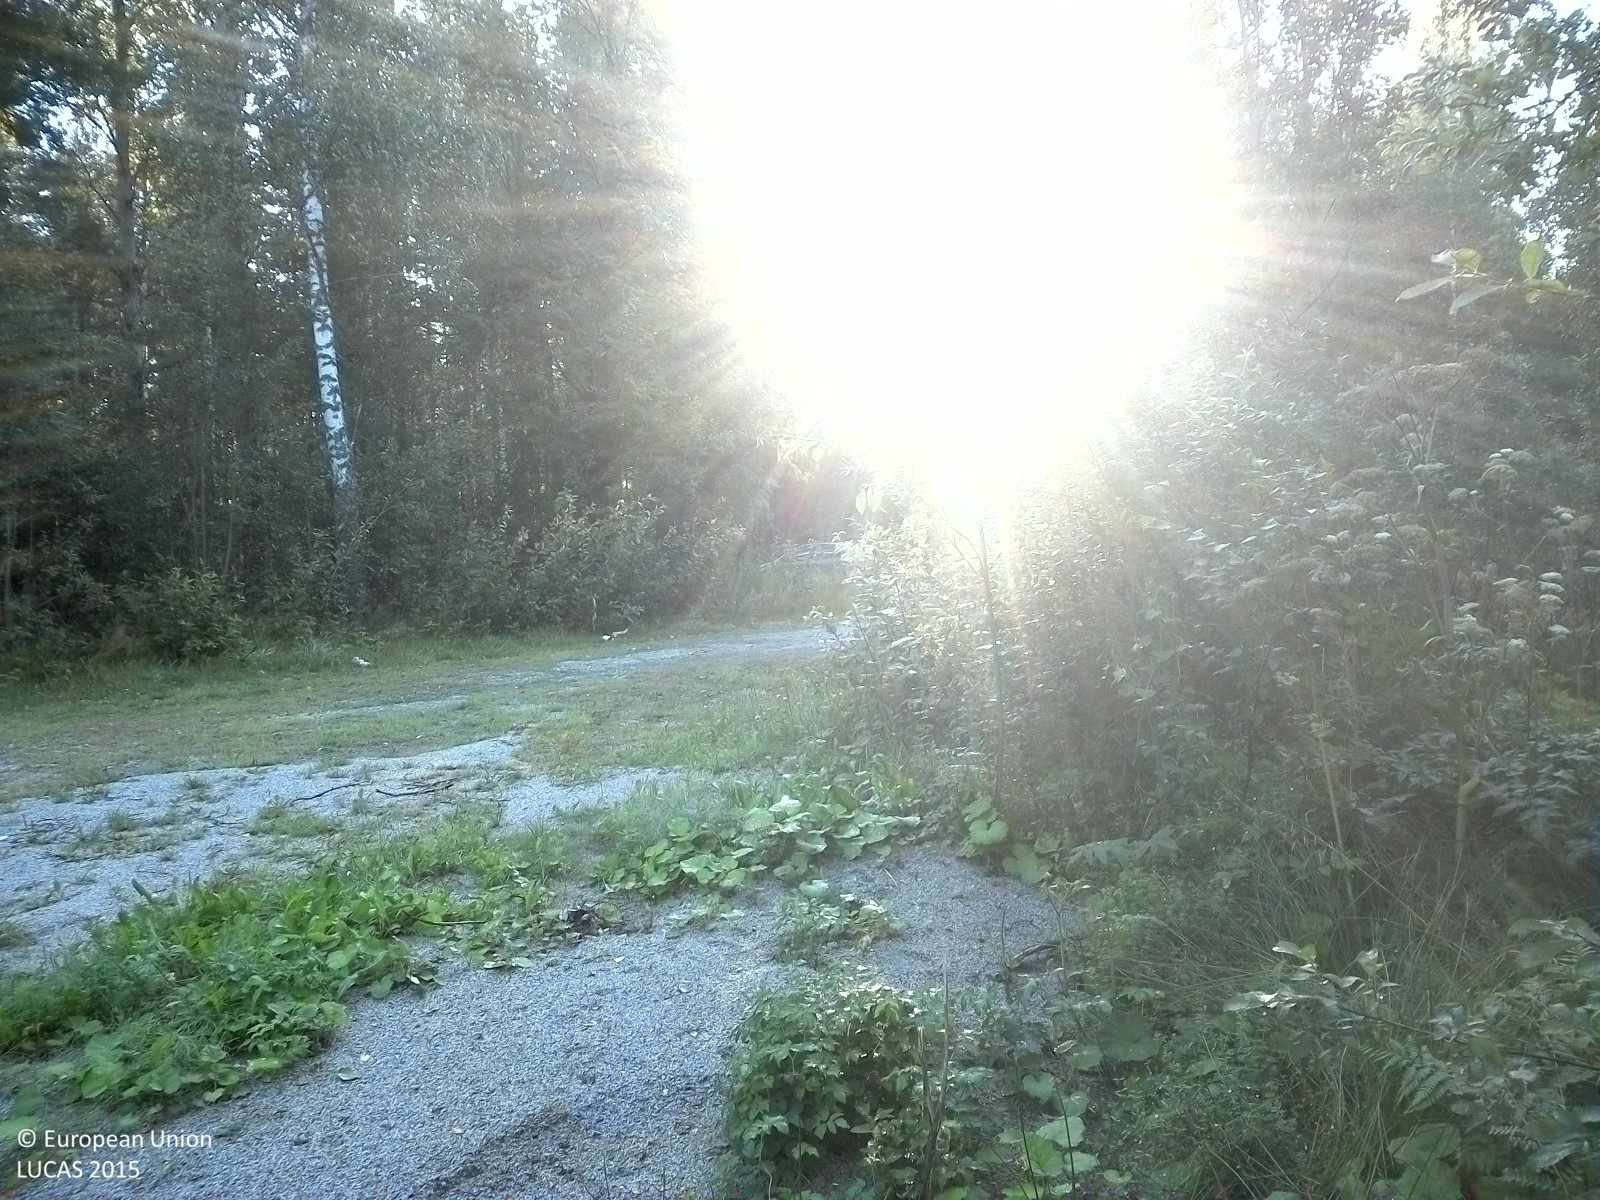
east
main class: Woodland
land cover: Other mixed woodland
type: hemiboreal forest and nemoral coniferous forest and mixed broadleaved-coniferous forest
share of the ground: 25 - 50 %
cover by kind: herbaceous plants 45 %, broadleaved forest trees 25 %, coniferous forest trees 20 %, lichens and mosses 10 %
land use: Forestry
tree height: > 5 m
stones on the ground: < 10 %
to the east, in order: Other mixed woodland; Paved roads, cycling and walking lanes; Grass margins; Other mixed woodland; Spruce dominated mixed woodland; Other mixed woodland; Fences; Grassland without tree/shrub cover
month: August
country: SE
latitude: 59.2755
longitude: 15.1331
